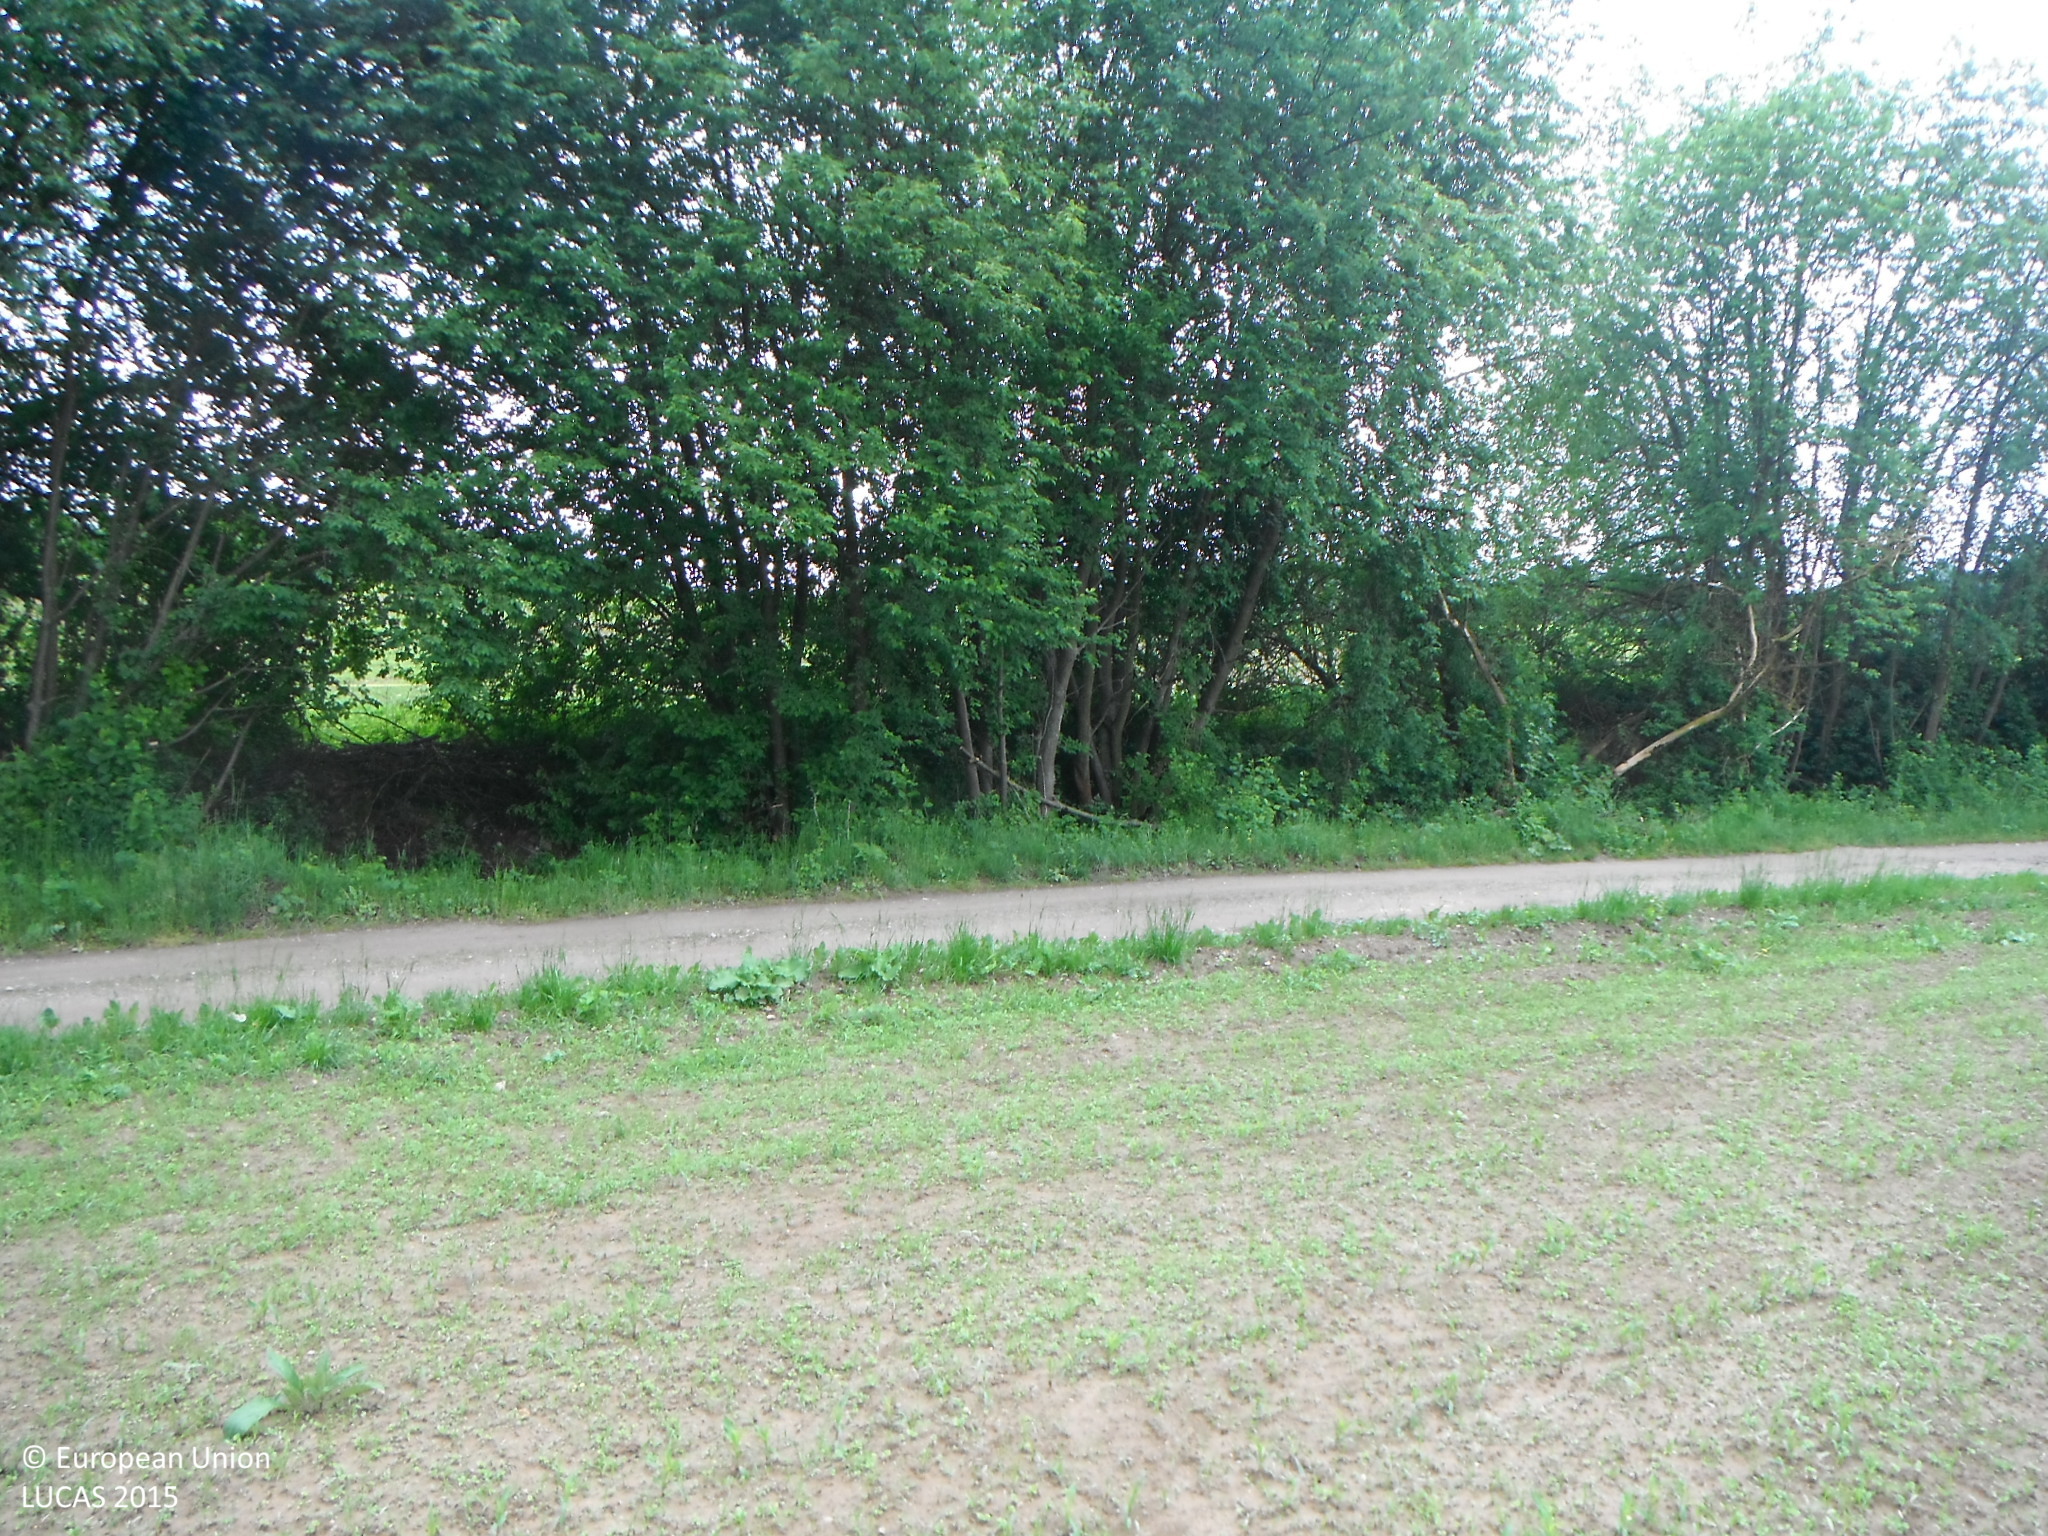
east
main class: Cropland
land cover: Maize
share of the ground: < 10 %
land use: Agriculture (excluding fallow land and kitchen gardens)
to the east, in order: Maize; Grass margins; Tracks; Grass margins; Abandoned hedges; Ditches and canals; Abandoned hedges; Maize; Spontaneously vegetated surfaces; Broadleaved woodland
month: May
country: SK
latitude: 48.7411
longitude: 19.2291
